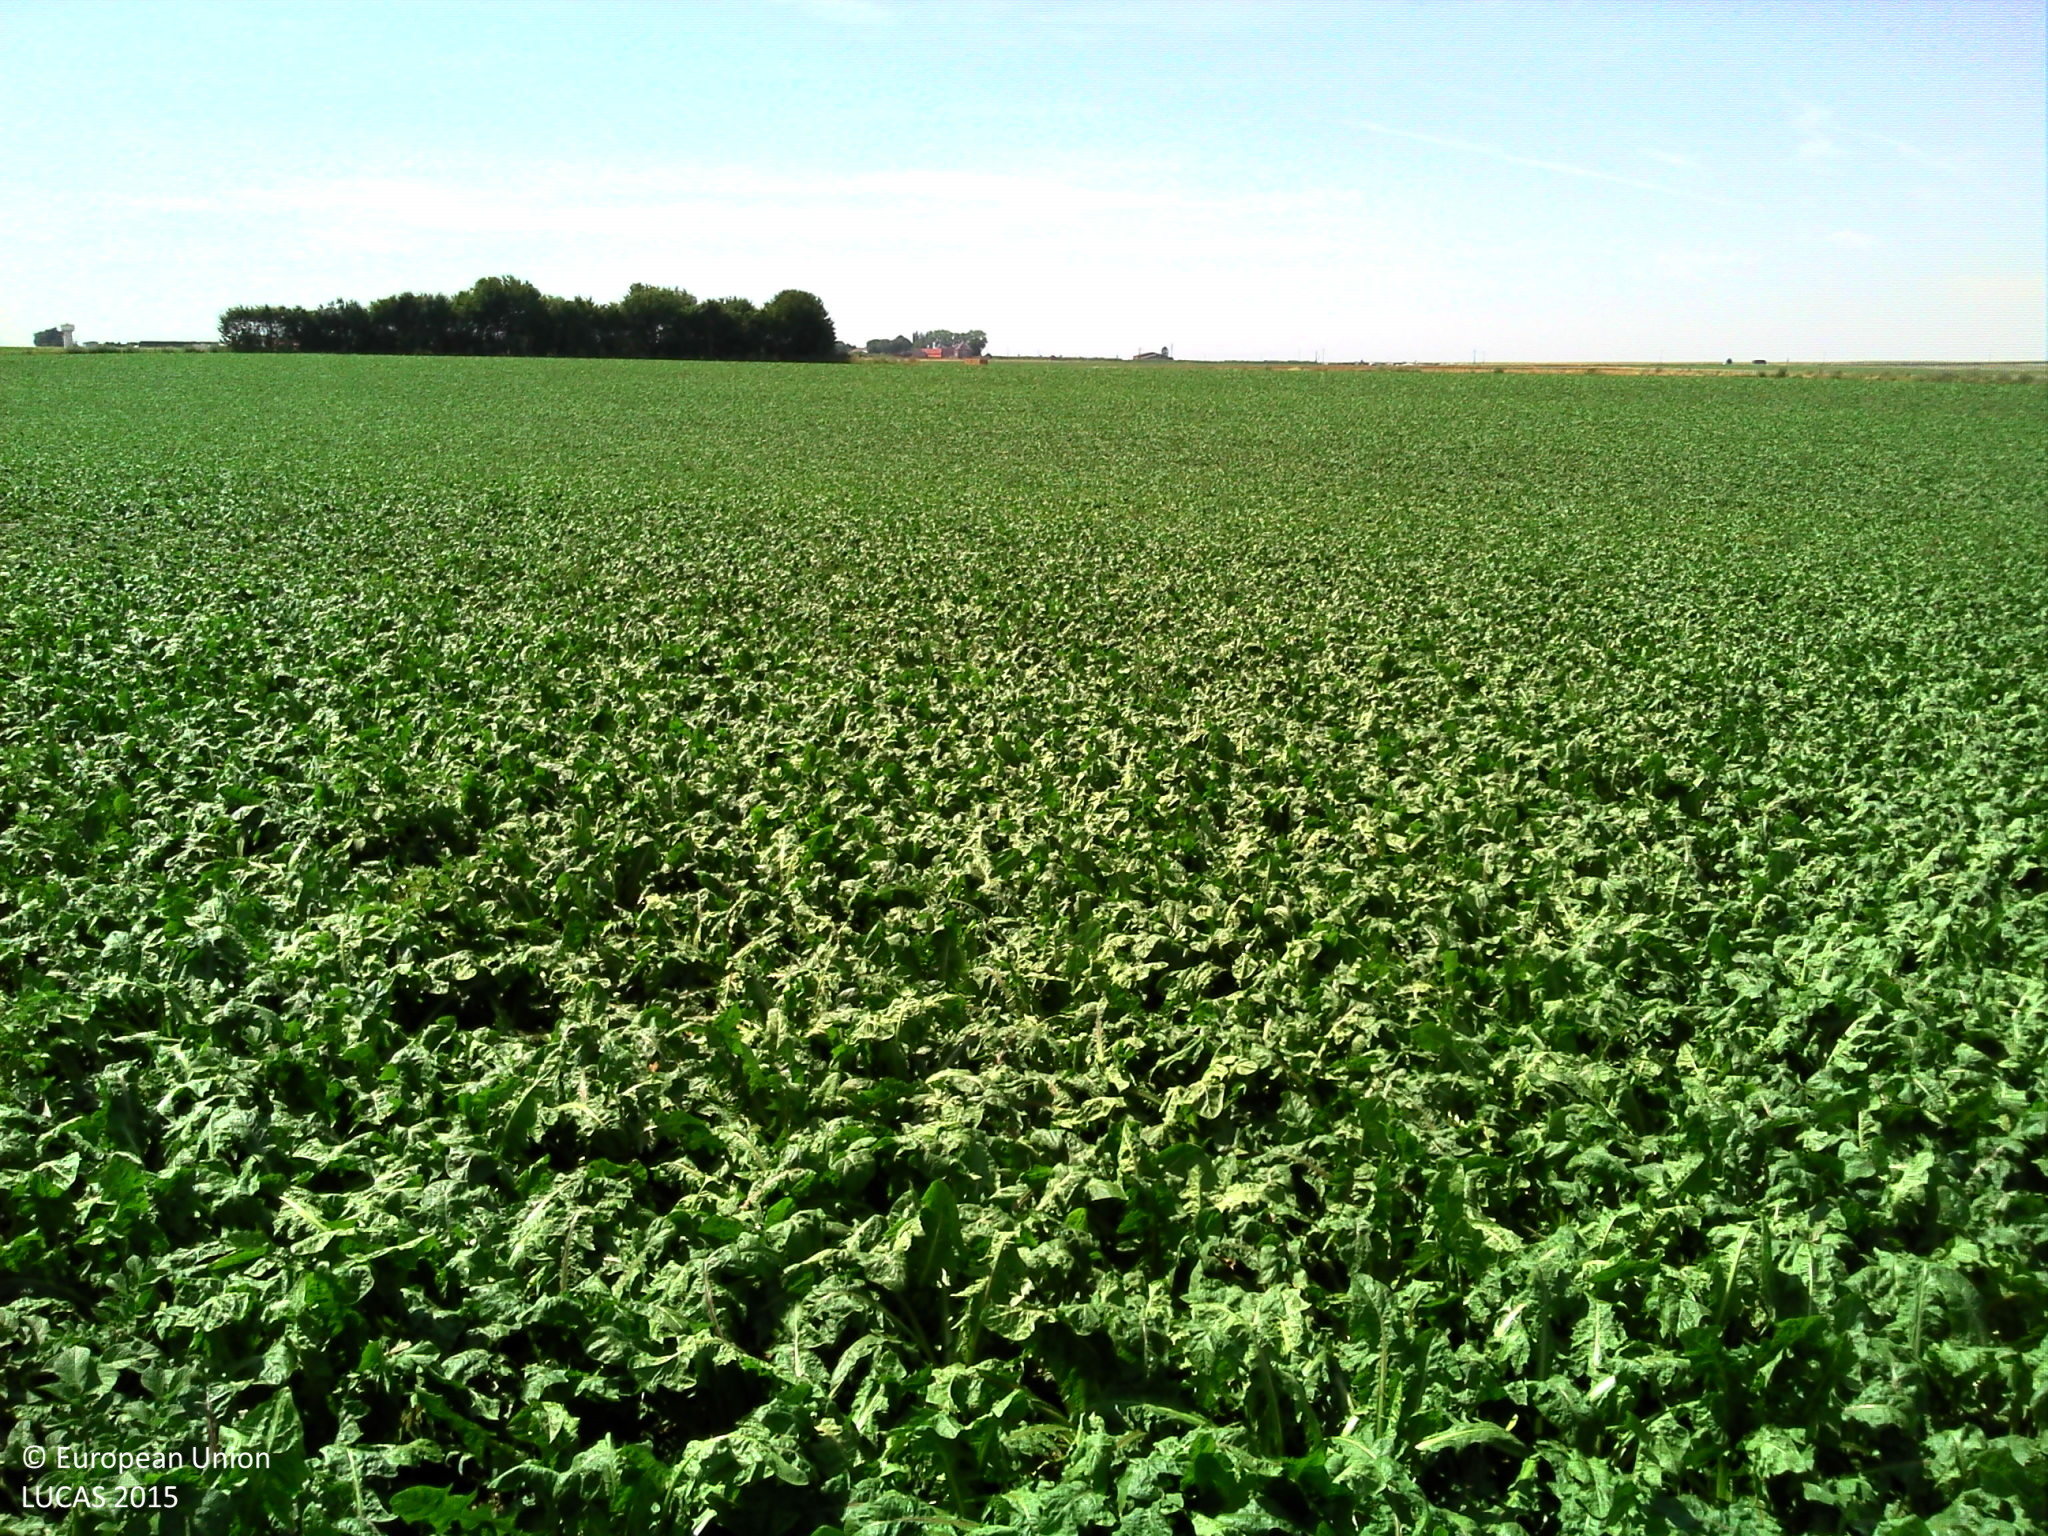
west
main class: Cropland
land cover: Other root crops
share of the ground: > 75 %
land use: Agriculture (excluding fallow land and kitchen gardens)
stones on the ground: < 10 %
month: August
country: FR
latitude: 50.2333
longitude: 3.1917
